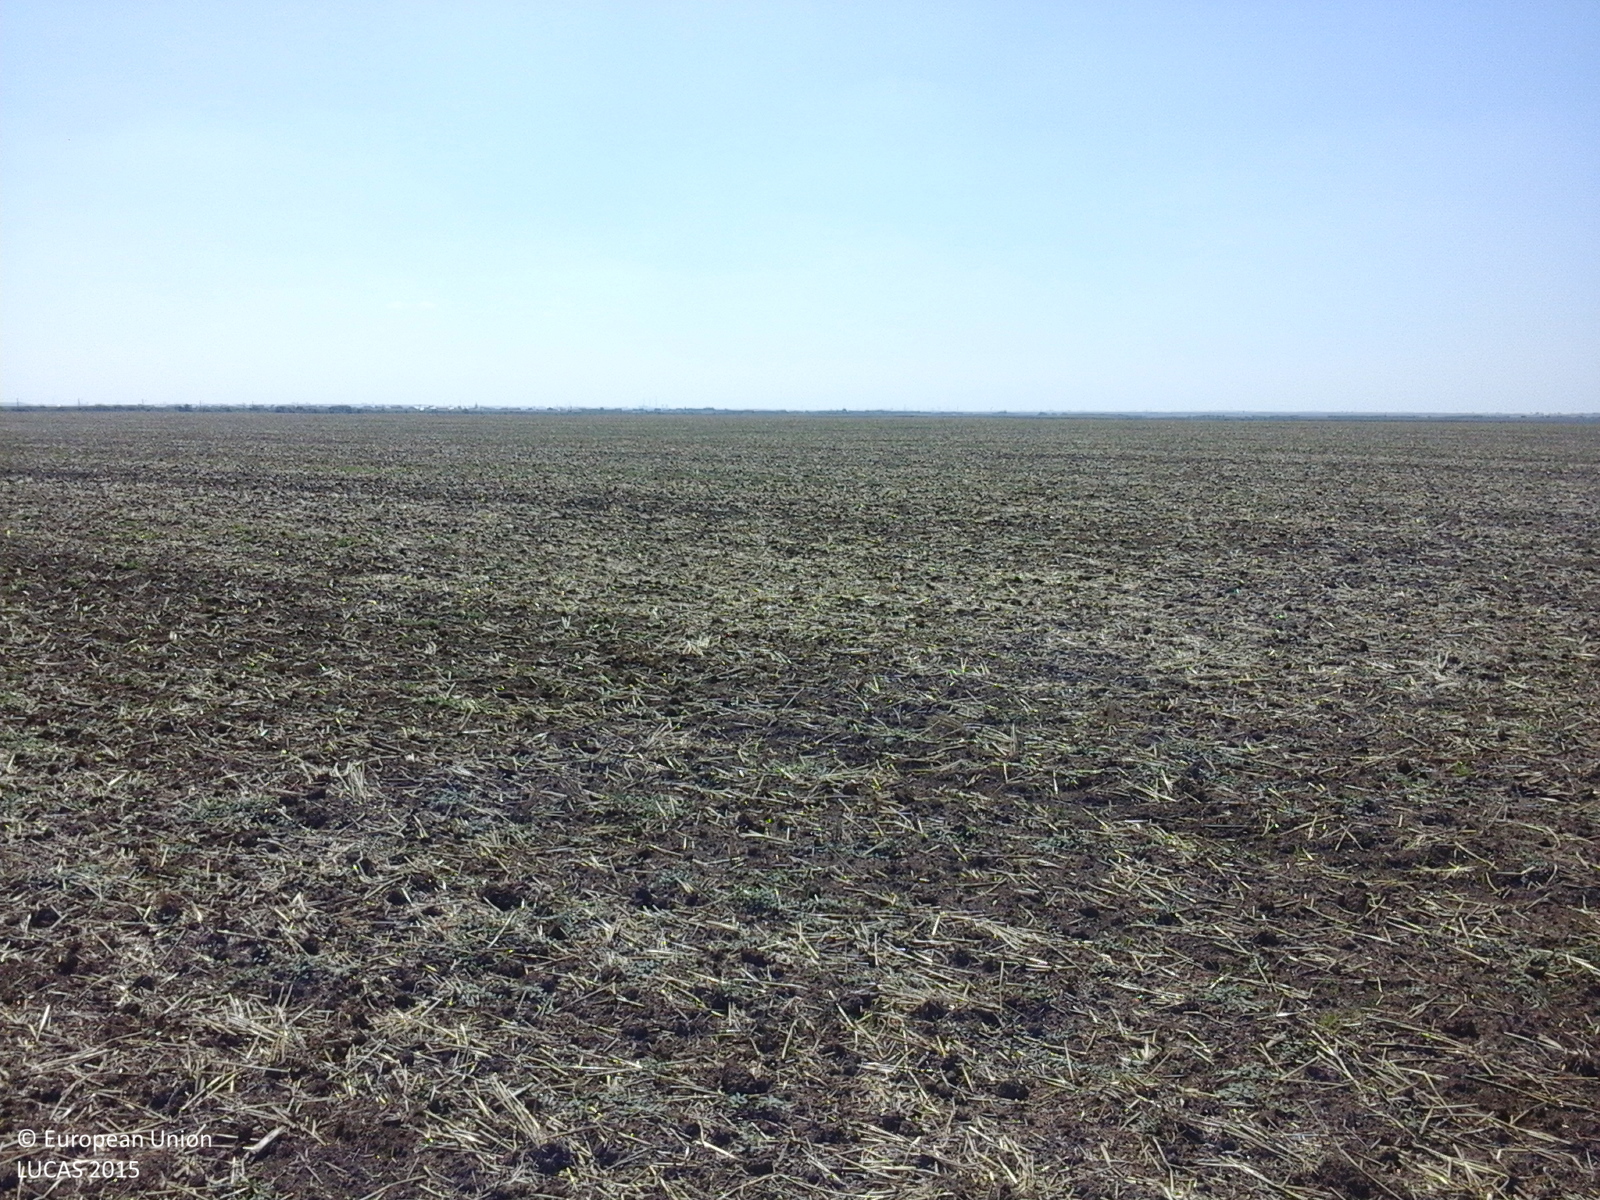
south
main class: Cropland
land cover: Common wheat
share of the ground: 25 - 50 %
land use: Agriculture (excluding fallow land and kitchen gardens)
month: August
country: RO
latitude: 45.8933
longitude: 21.1525
